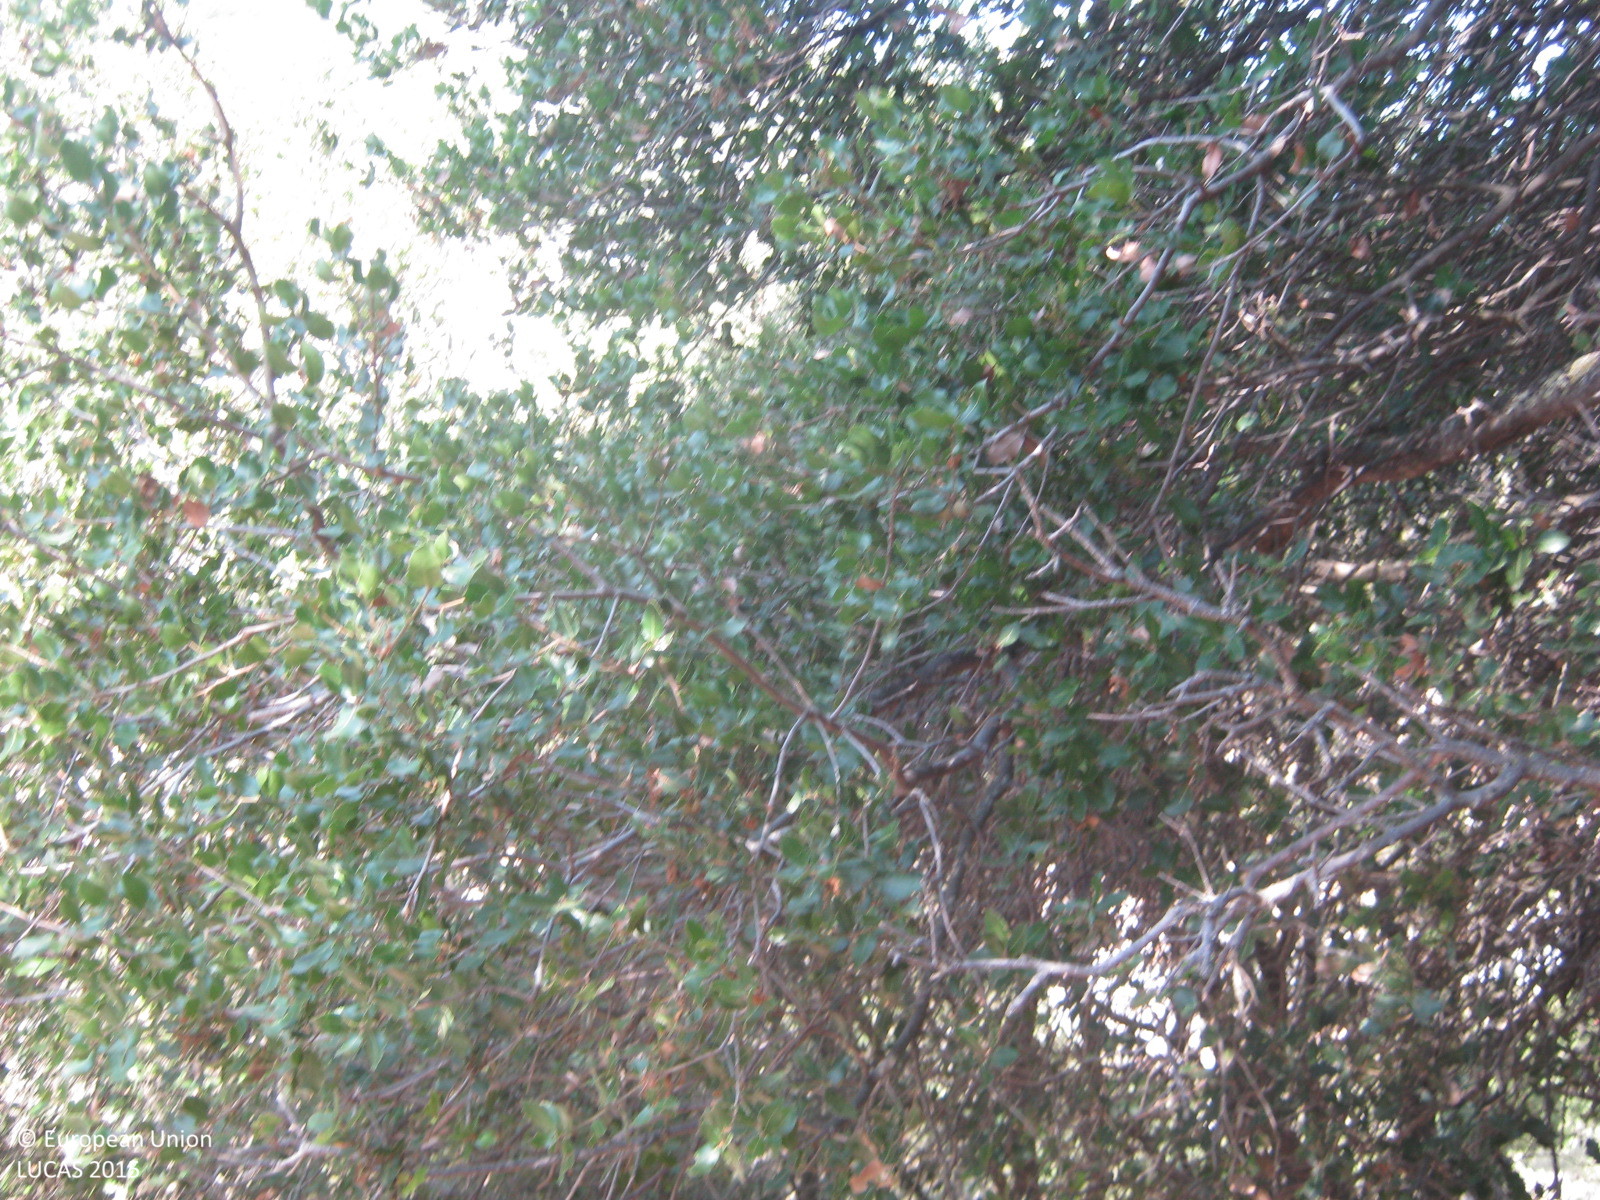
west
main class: Woodland
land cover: Broadleaved woodland
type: broadleaved evergreen forest
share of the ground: > 75 %
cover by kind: broadleaved forest trees 70 %, consolidated bare surface 20 %, shrubs 10 %
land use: Semi-natural and natural areas not in use
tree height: < 5 m
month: August
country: GR
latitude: 38.3110
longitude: 20.5412
